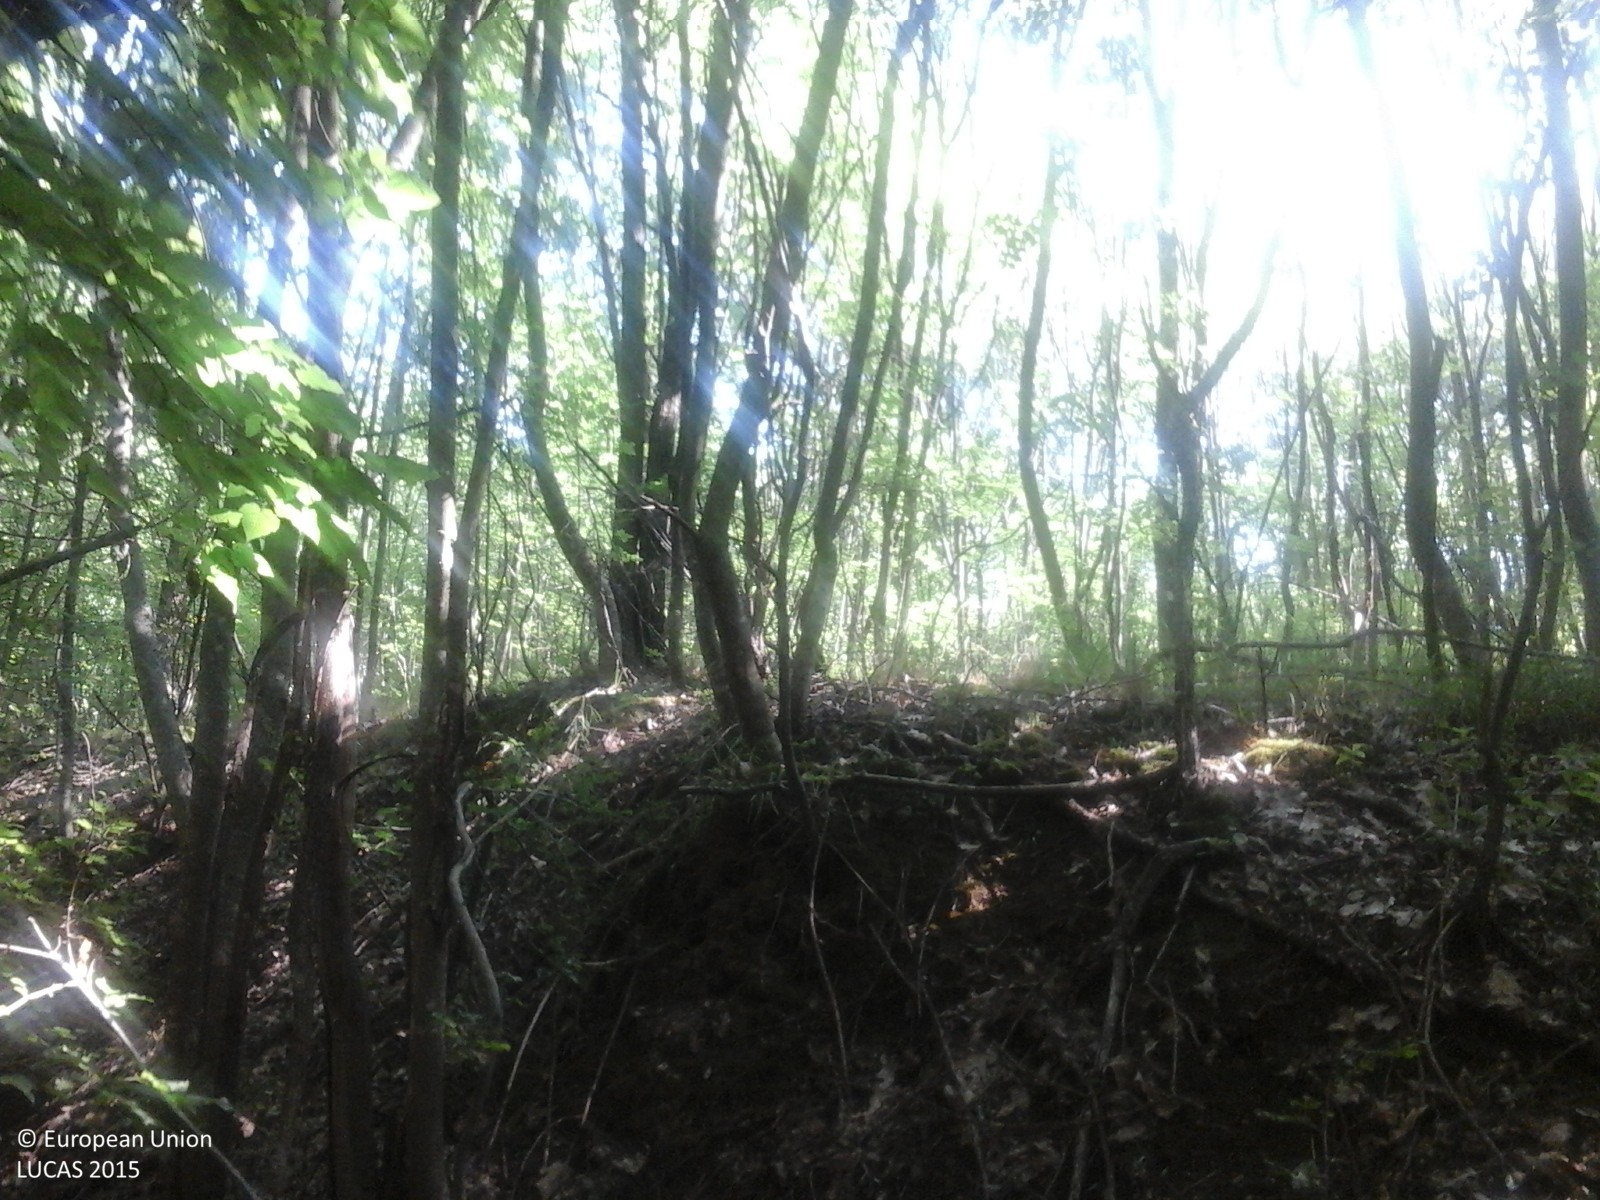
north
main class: Woodland
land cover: Broadleaved woodland
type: beech forest
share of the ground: > 75 %
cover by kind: broadleaved forest trees 100 %
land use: Forestry
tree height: > 5 m
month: July
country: RO
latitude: 44.7689
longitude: 24.3869
